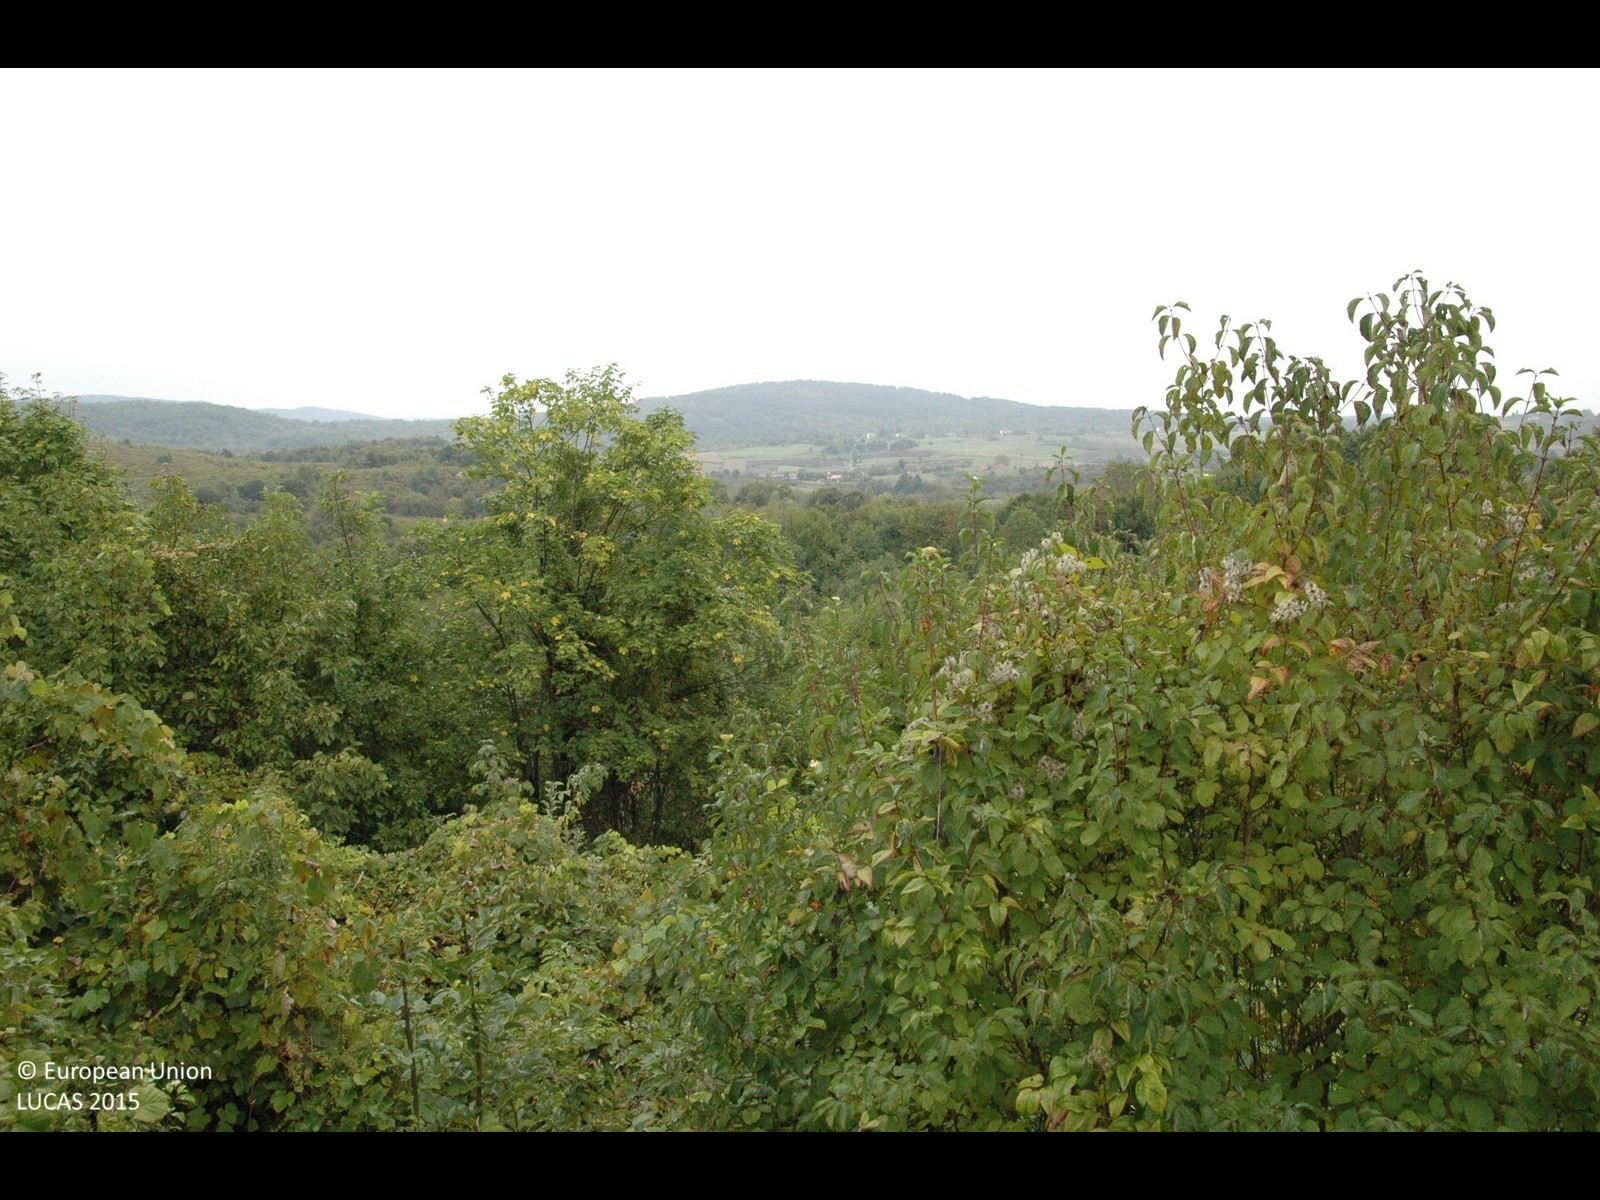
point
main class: Shrubland
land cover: Shrubland with sparse tree cover
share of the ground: > 75 %
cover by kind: shrubs 95 %, broadleaved forest trees 5 %
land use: Semi-natural and natural areas not in use
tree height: > 5 m
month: September
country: HR
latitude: 45.0103
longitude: 15.6412
